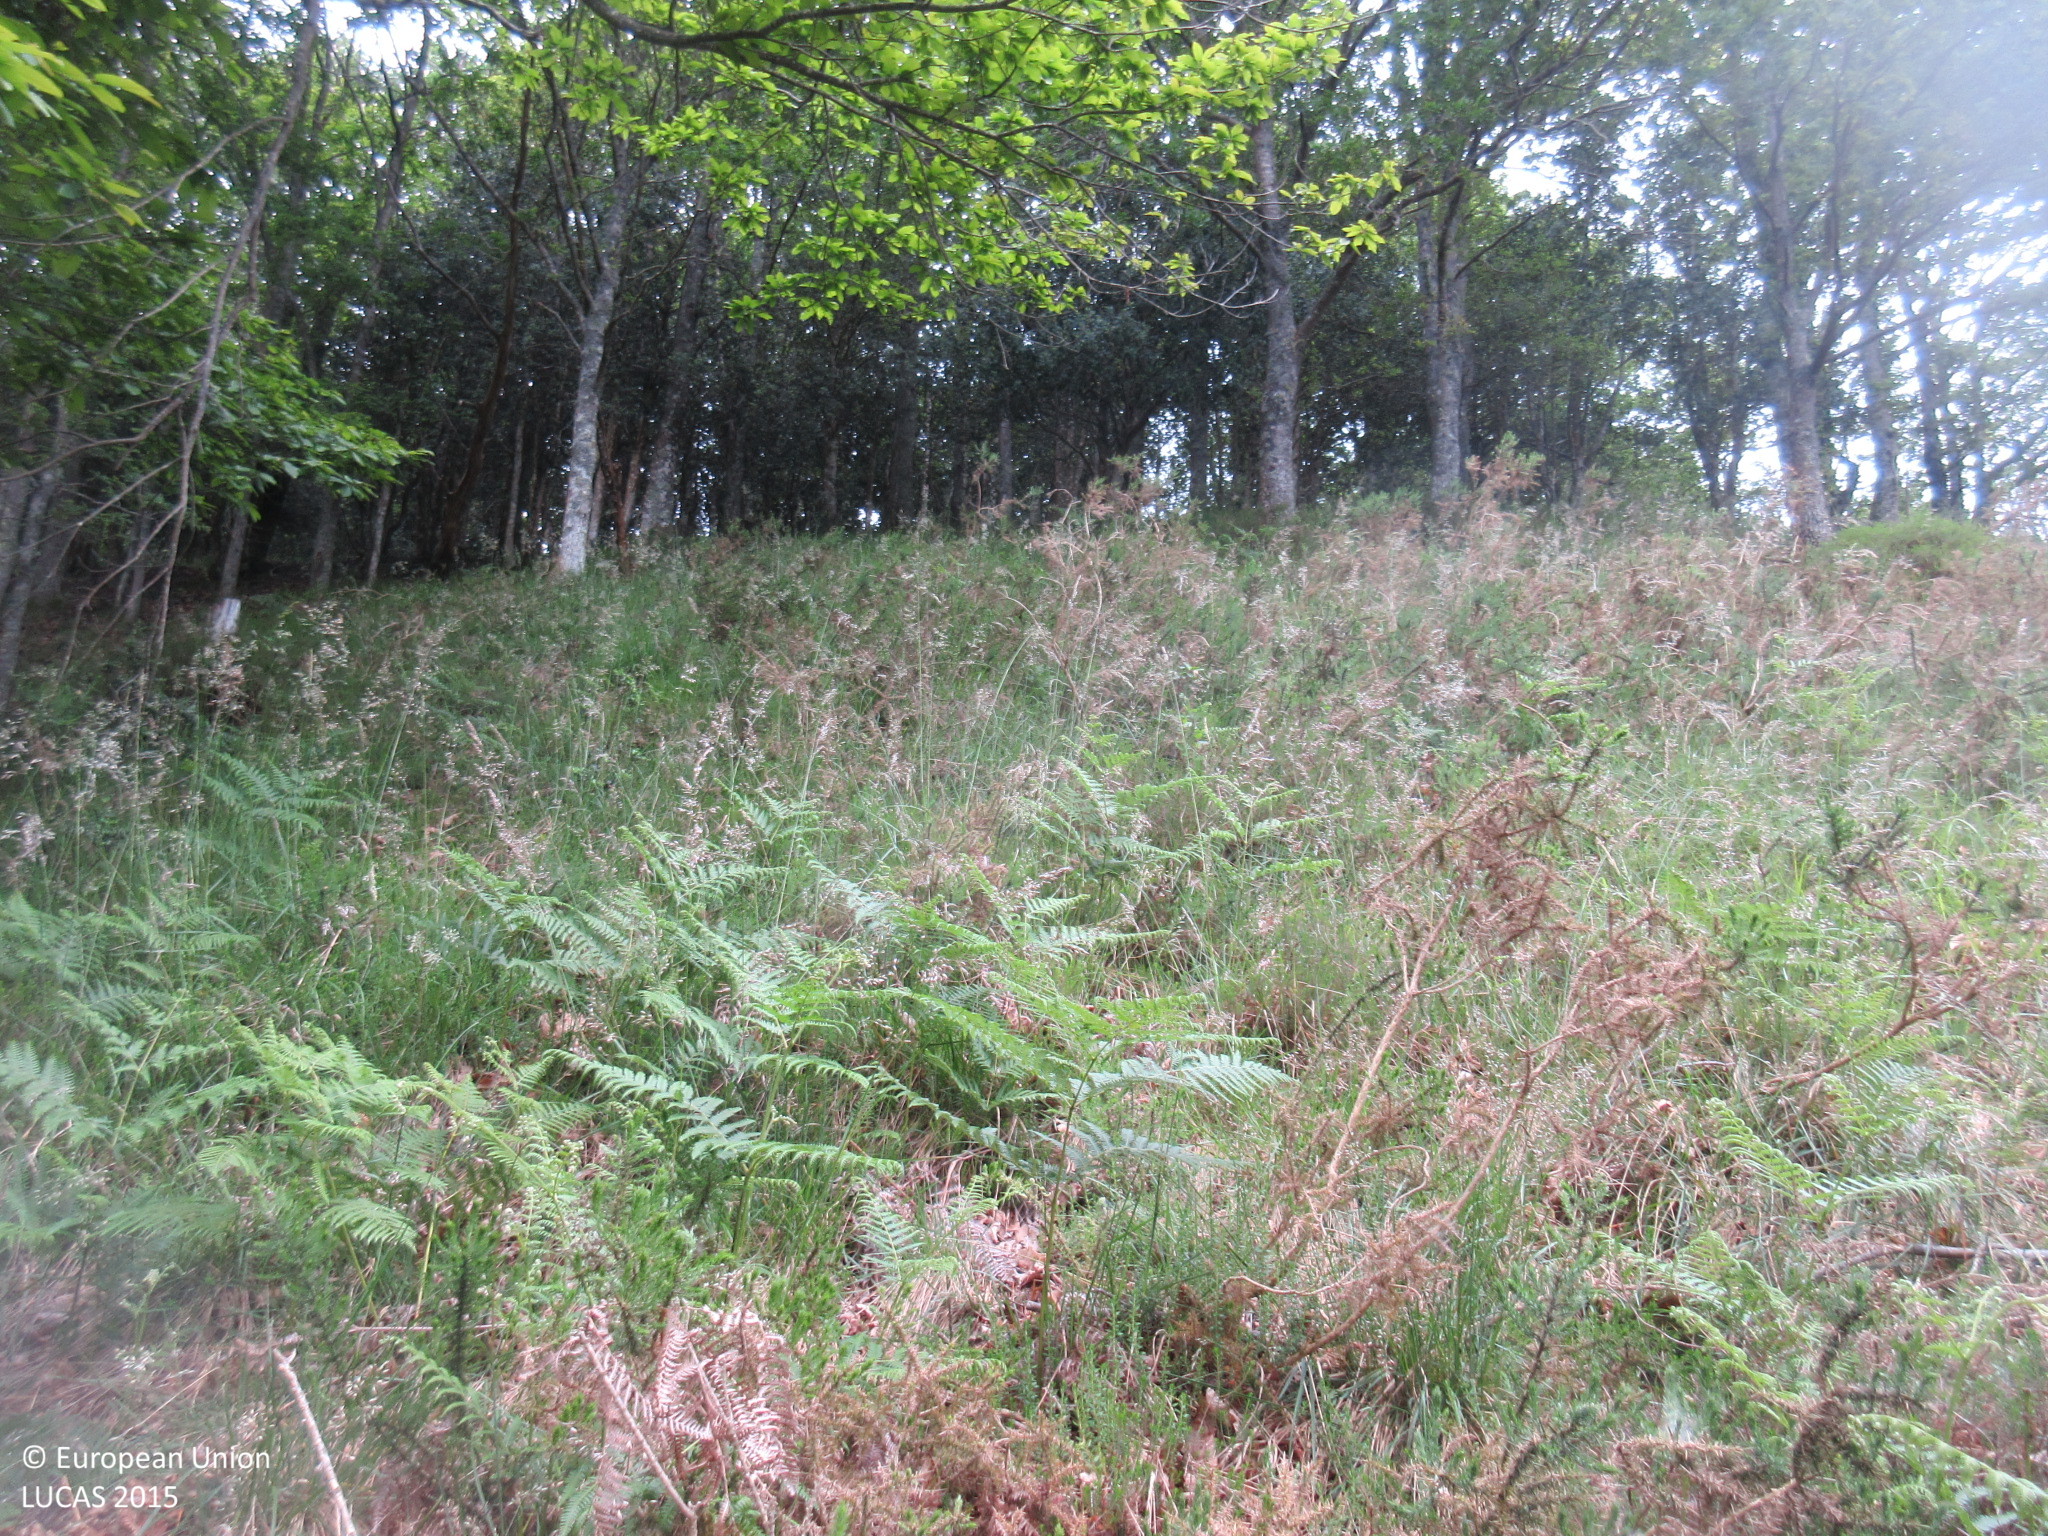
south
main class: Woodland
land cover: Broadleaved woodland
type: acidophilous oak and oak-birch forest
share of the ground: 50 - 75 %
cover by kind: broadleaved forest trees 70 %, shrubs 30 %
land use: Semi-natural and natural areas not in use
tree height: > 5 m
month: June
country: ES
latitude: 43.2220
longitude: -4.1990
